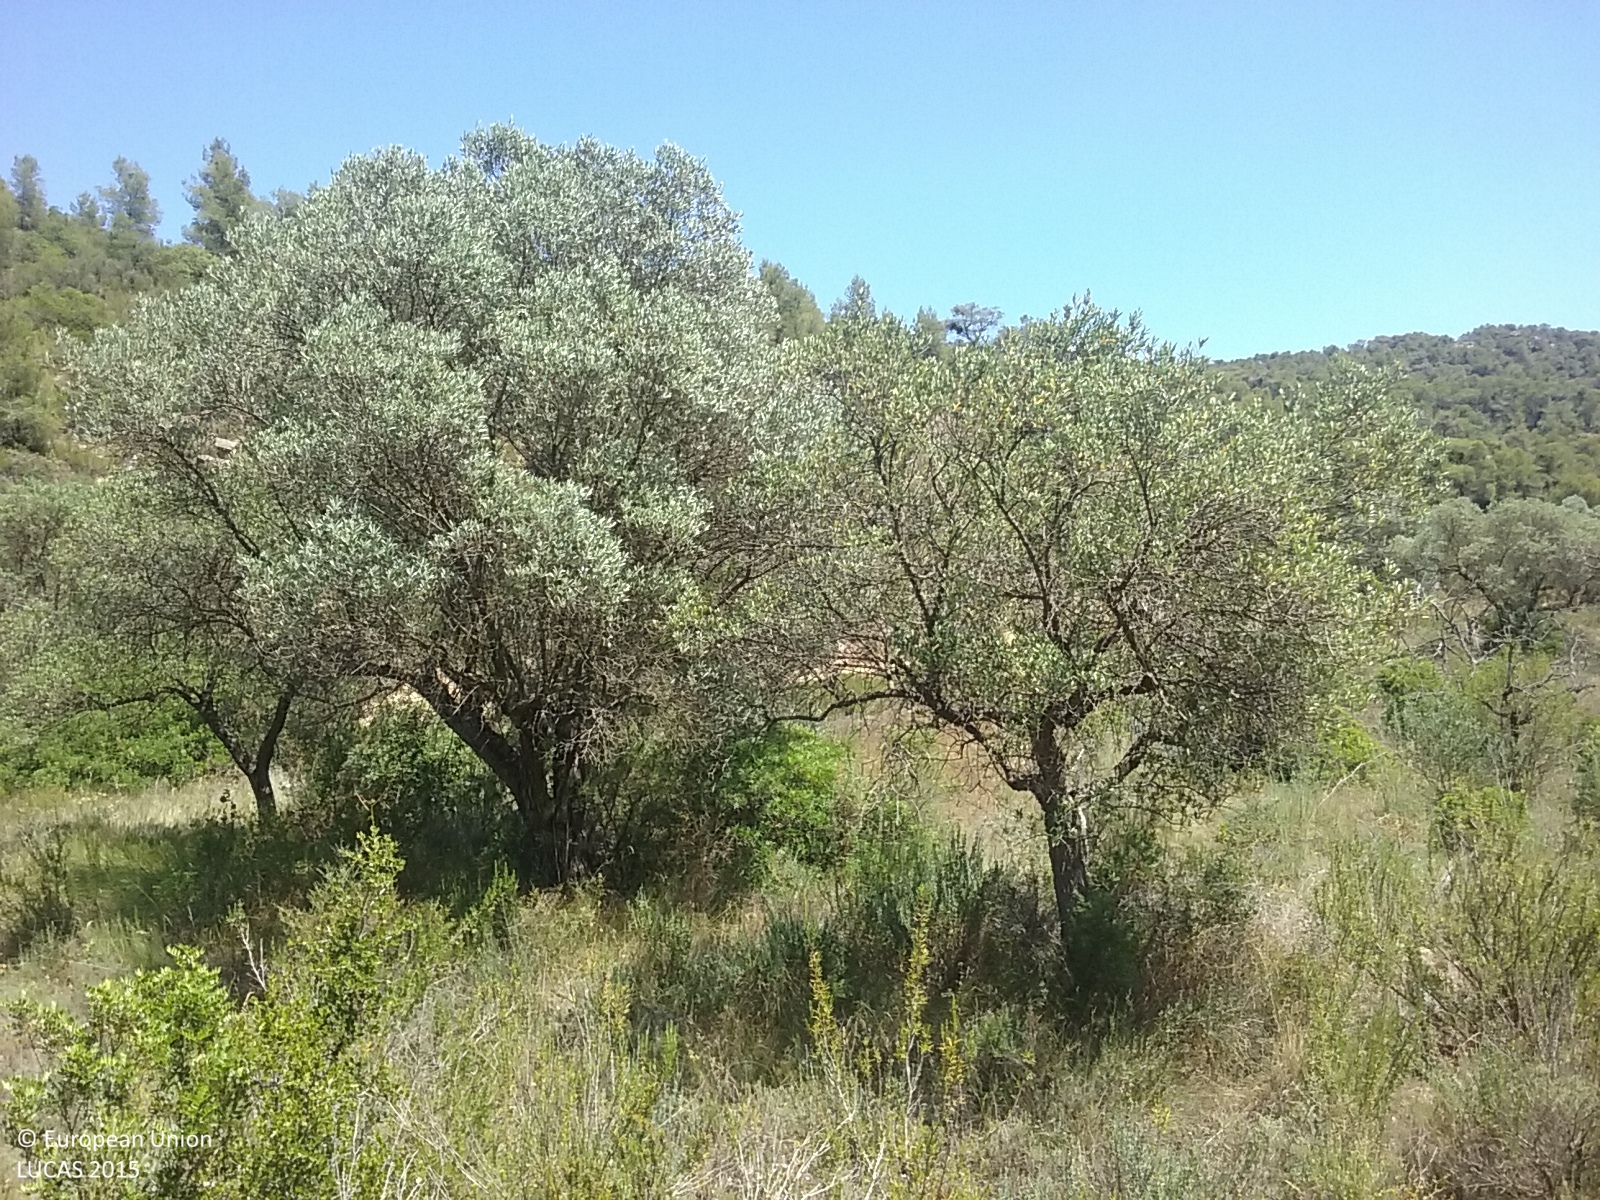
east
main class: Woodland
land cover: Pine dominated coniferous woodland
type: coniferous forest of the mediterranean region
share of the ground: 10 - 25 %
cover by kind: shrubs 75 %, coniferous forest trees 25 %
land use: Semi-natural and natural areas not in use
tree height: > 5 m
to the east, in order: Dry stone walls; Olive groves; Dry stone walls; Nuts trees; Tracks; Pine dominated coniferous woodland; Shrubland with sparse tree cover; Pine dominated coniferous woodland; Dry stone walls; Pine dominated coniferous woodland; Shrubland with sparse tree cover; Dry stone walls; Olive groves; Dry stone walls; Tracks; Nuts trees; Dry stone walls; Groves; Nuts trees; Dry stone walls; Groves; Nuts trees; Dry stone walls; Abandoned hedges; Nuts trees
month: June
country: ES
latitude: 41.3128
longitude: 0.4691
